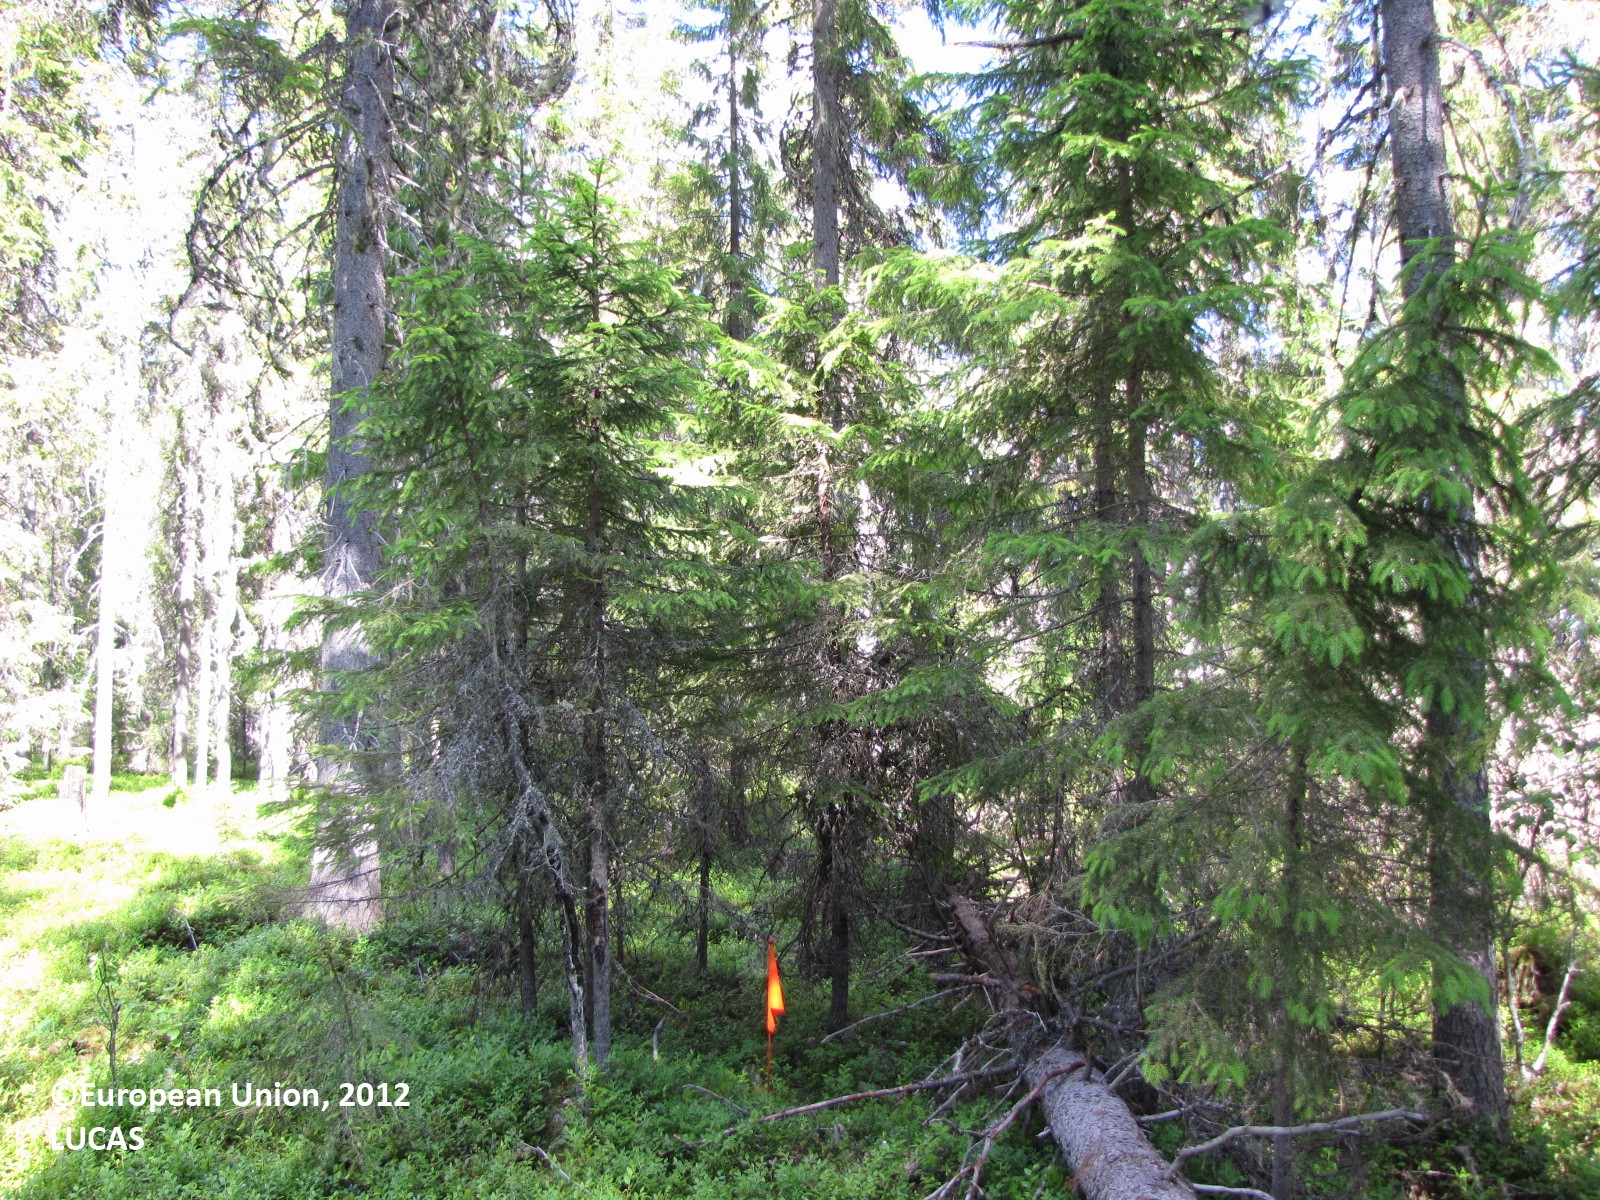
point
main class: Woodland
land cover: Spruce dominated coniferous woodland
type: boreal forest
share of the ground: 50 - 75 %
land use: Forestry
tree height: > 5 m
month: July
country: FI
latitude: 66.2728
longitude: 25.1373
